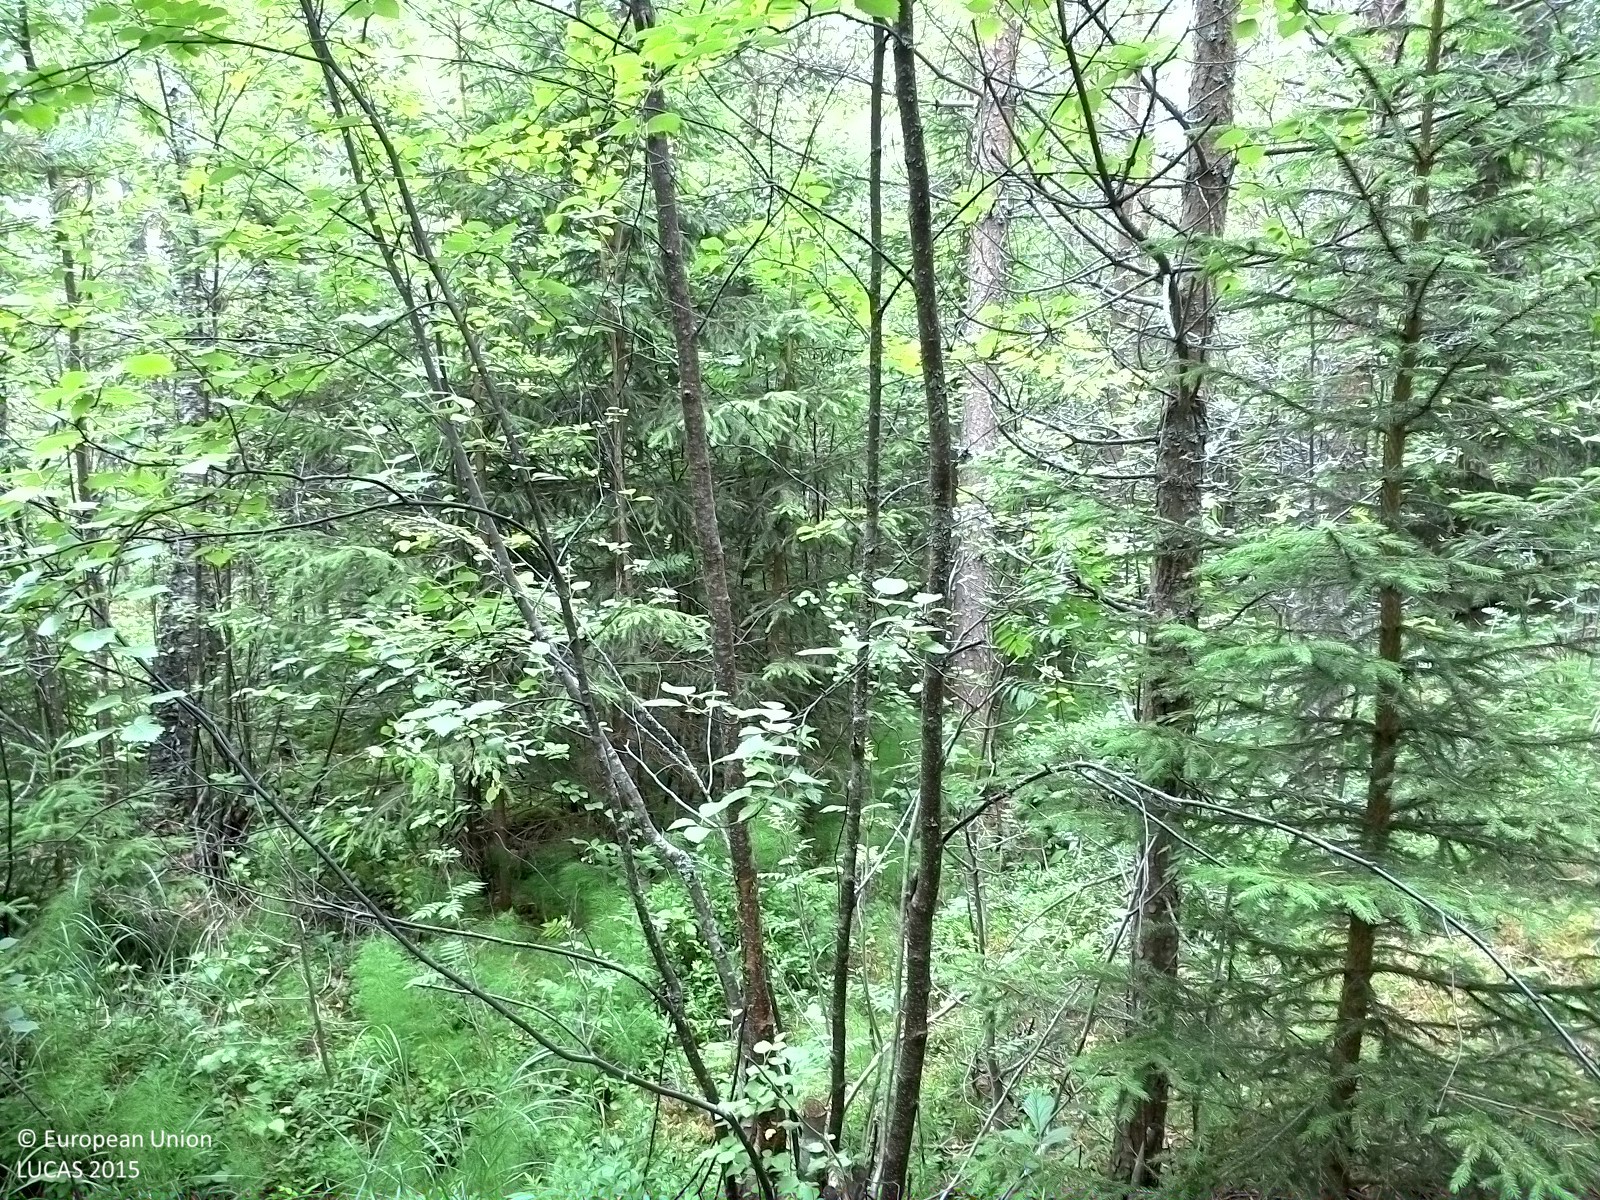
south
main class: Woodland
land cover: Other mixed woodland
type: boreal forest
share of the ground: > 75 %
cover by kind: coniferous forest trees 40 %, broadleaved forest trees 40 %, shrubs 15 %, herbaceous plants 5 %
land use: Forestry
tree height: > 5 m
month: July
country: SE
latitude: 62.5224
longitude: 17.7319
